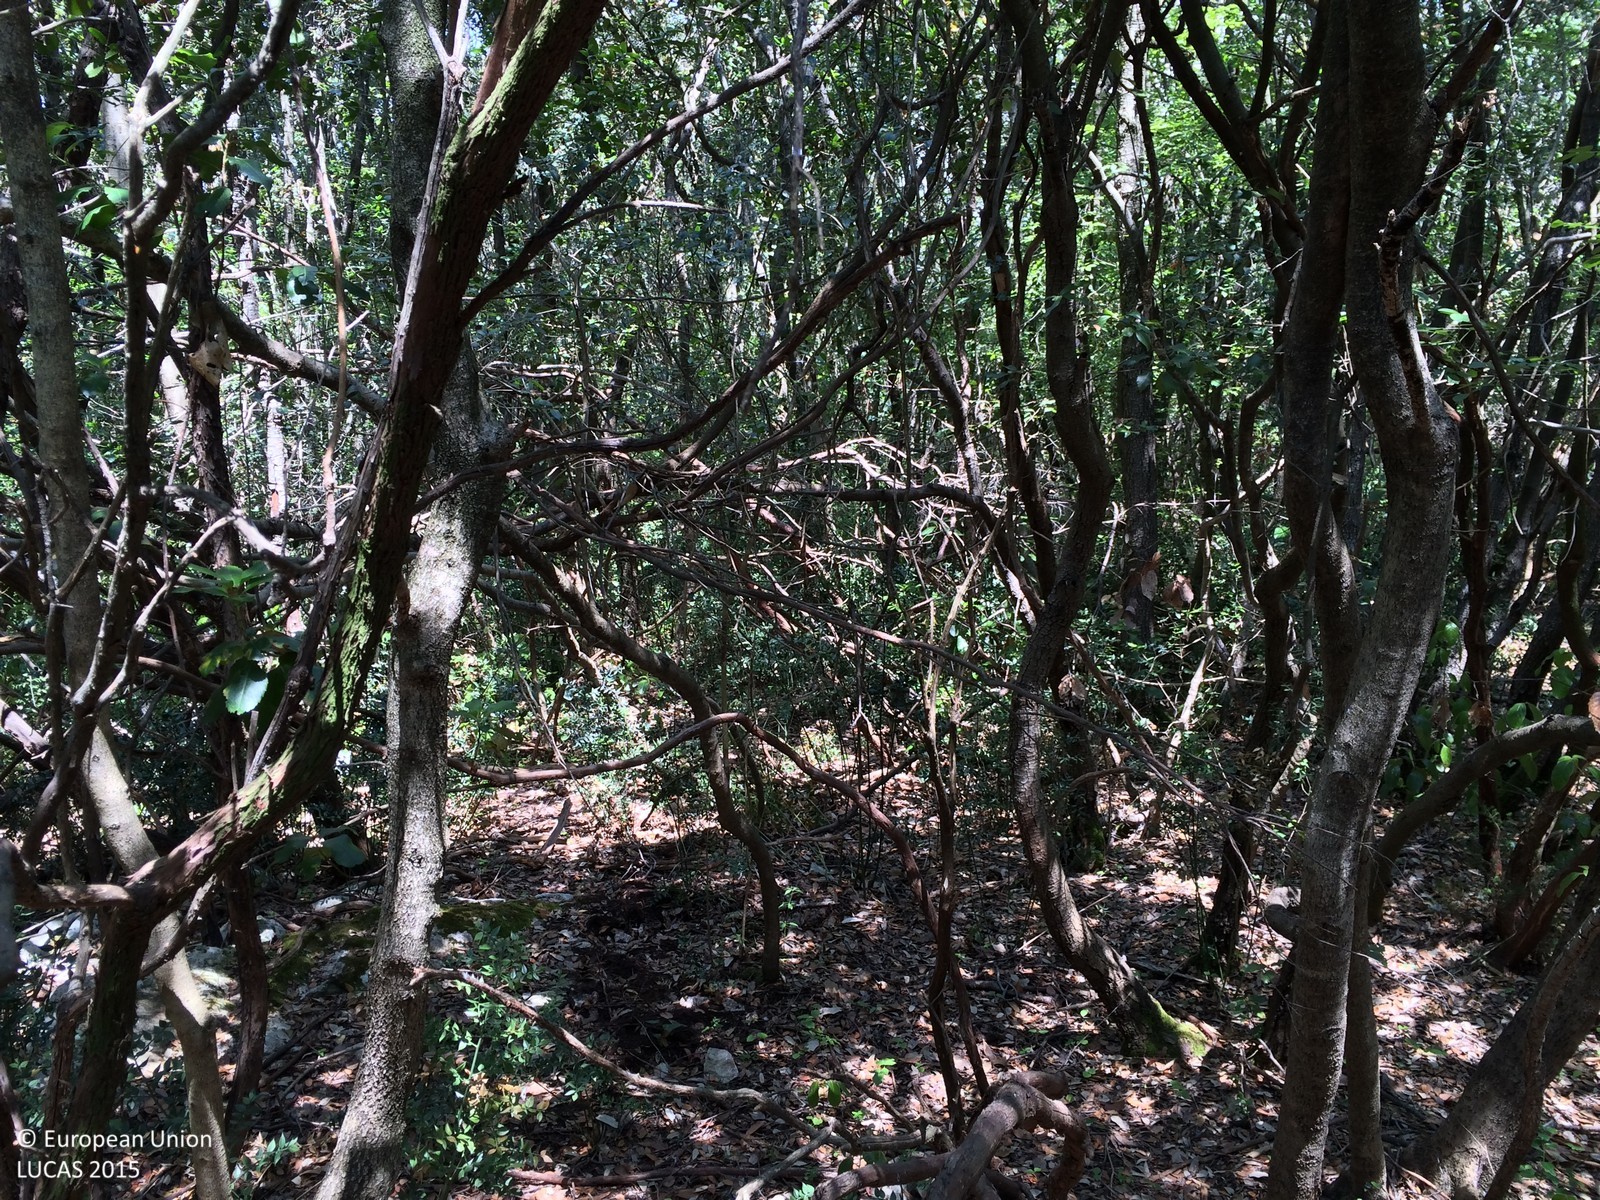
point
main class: Woodland
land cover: Broadleaved woodland
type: broadleaved evergreen forest
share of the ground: > 75 %
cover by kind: broadleaved forest trees 95 %, shrubs 5 %
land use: Semi-natural and natural areas not in use
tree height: > 5 m
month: June
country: HR
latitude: 44.9580
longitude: 14.0380
